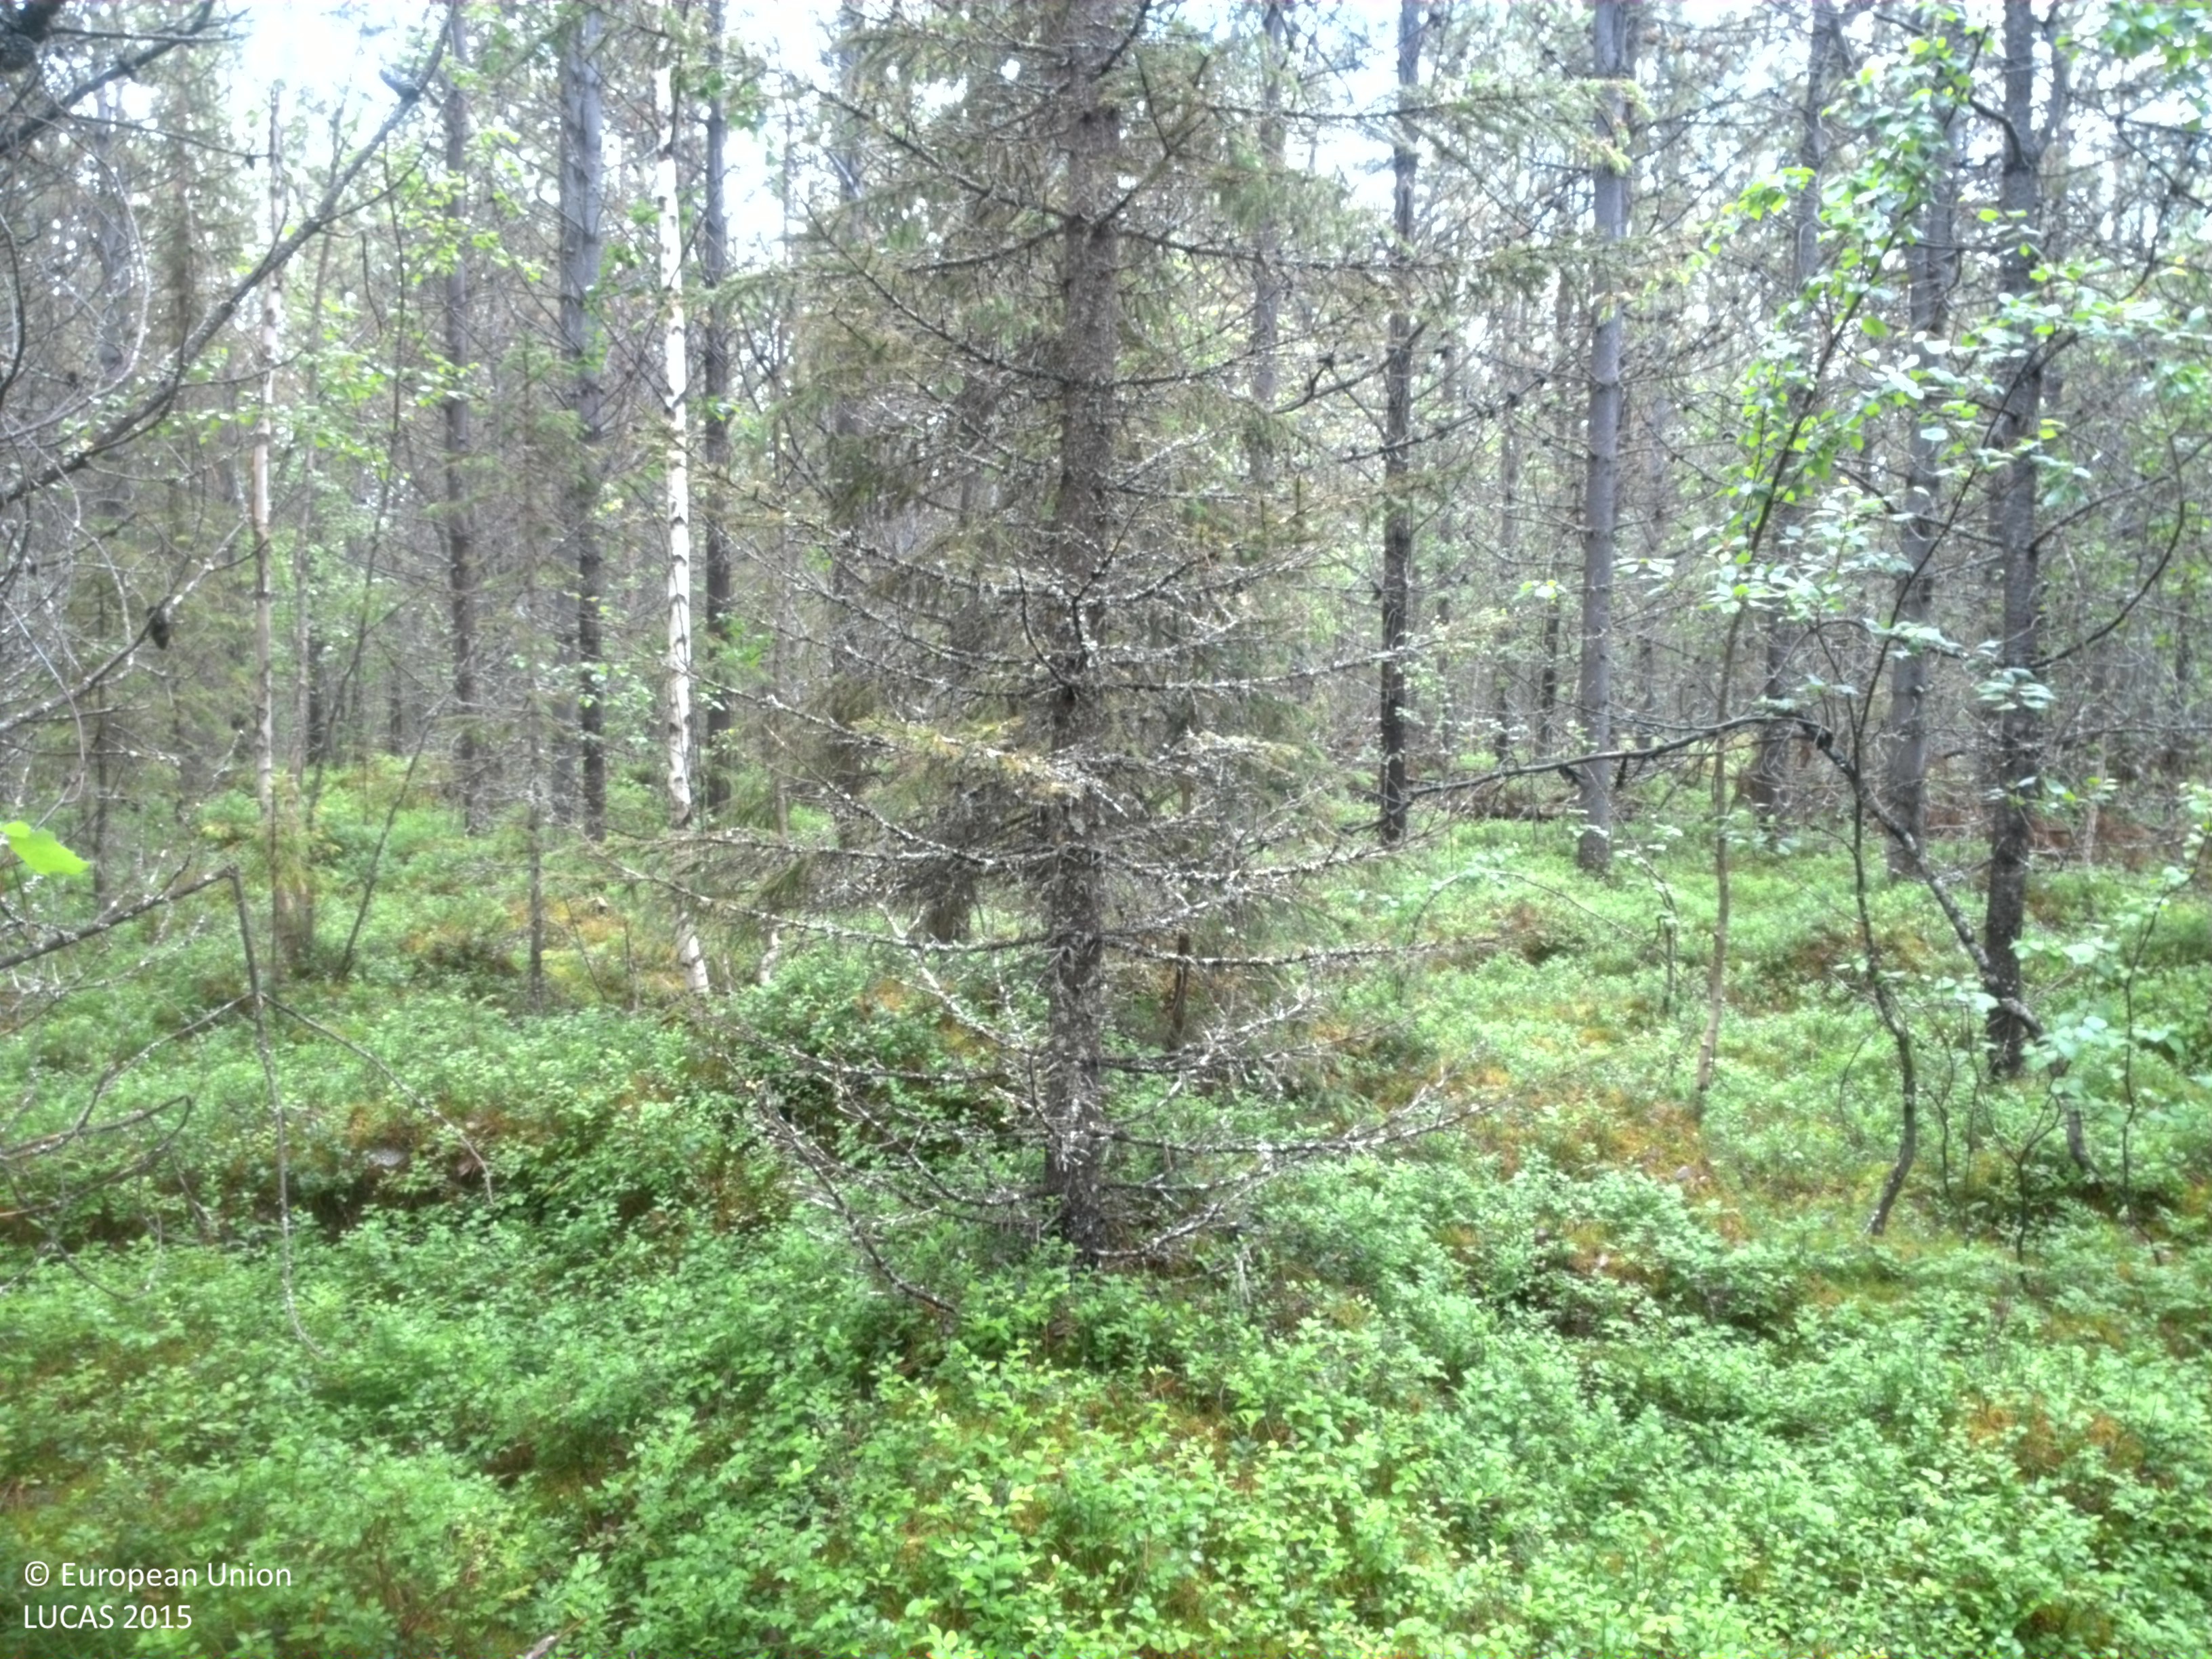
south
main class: Woodland
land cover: Pine dominated coniferous woodland
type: exotic forest
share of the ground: 50 - 75 %
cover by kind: coniferous forest trees 55 %, shrubs 40 %, broadleaved forest trees 5 %
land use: Forestry
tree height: > 5 m
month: July
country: SE
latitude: 66.1175
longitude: 20.4300
